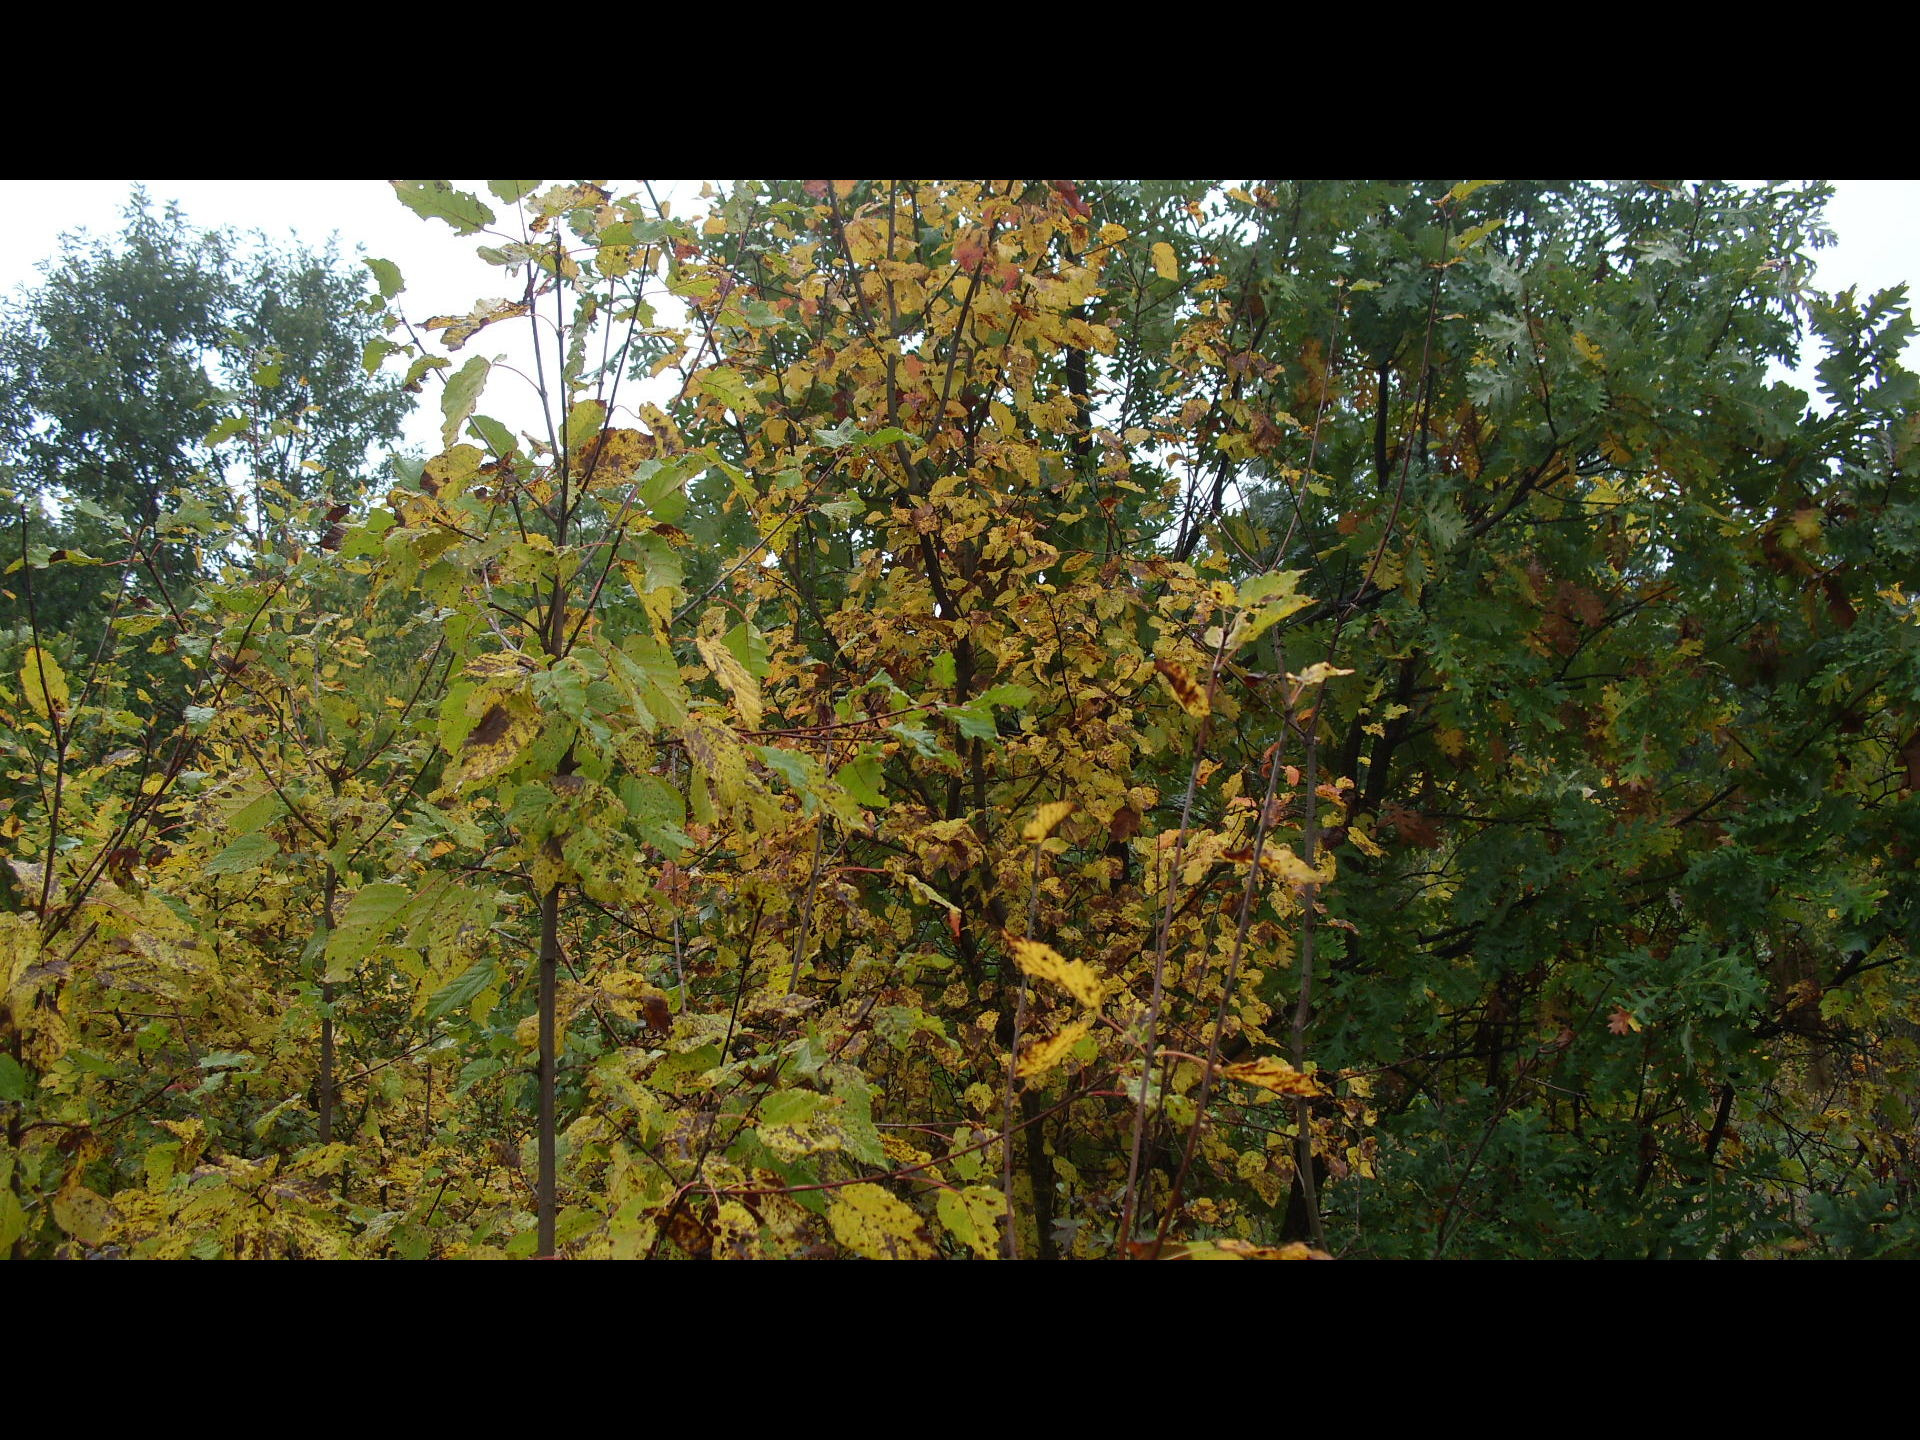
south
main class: Grassland
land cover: Grassland with sparse tree/shrub cover
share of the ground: > 75 %
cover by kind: herbaceous plants 90 %, broadleaved forest trees 5 %, shrubs 5 %
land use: Semi-natural and natural areas not in use
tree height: < 5 m
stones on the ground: < 10 %
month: October
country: BG
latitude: 43.6915
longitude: 22.5762
